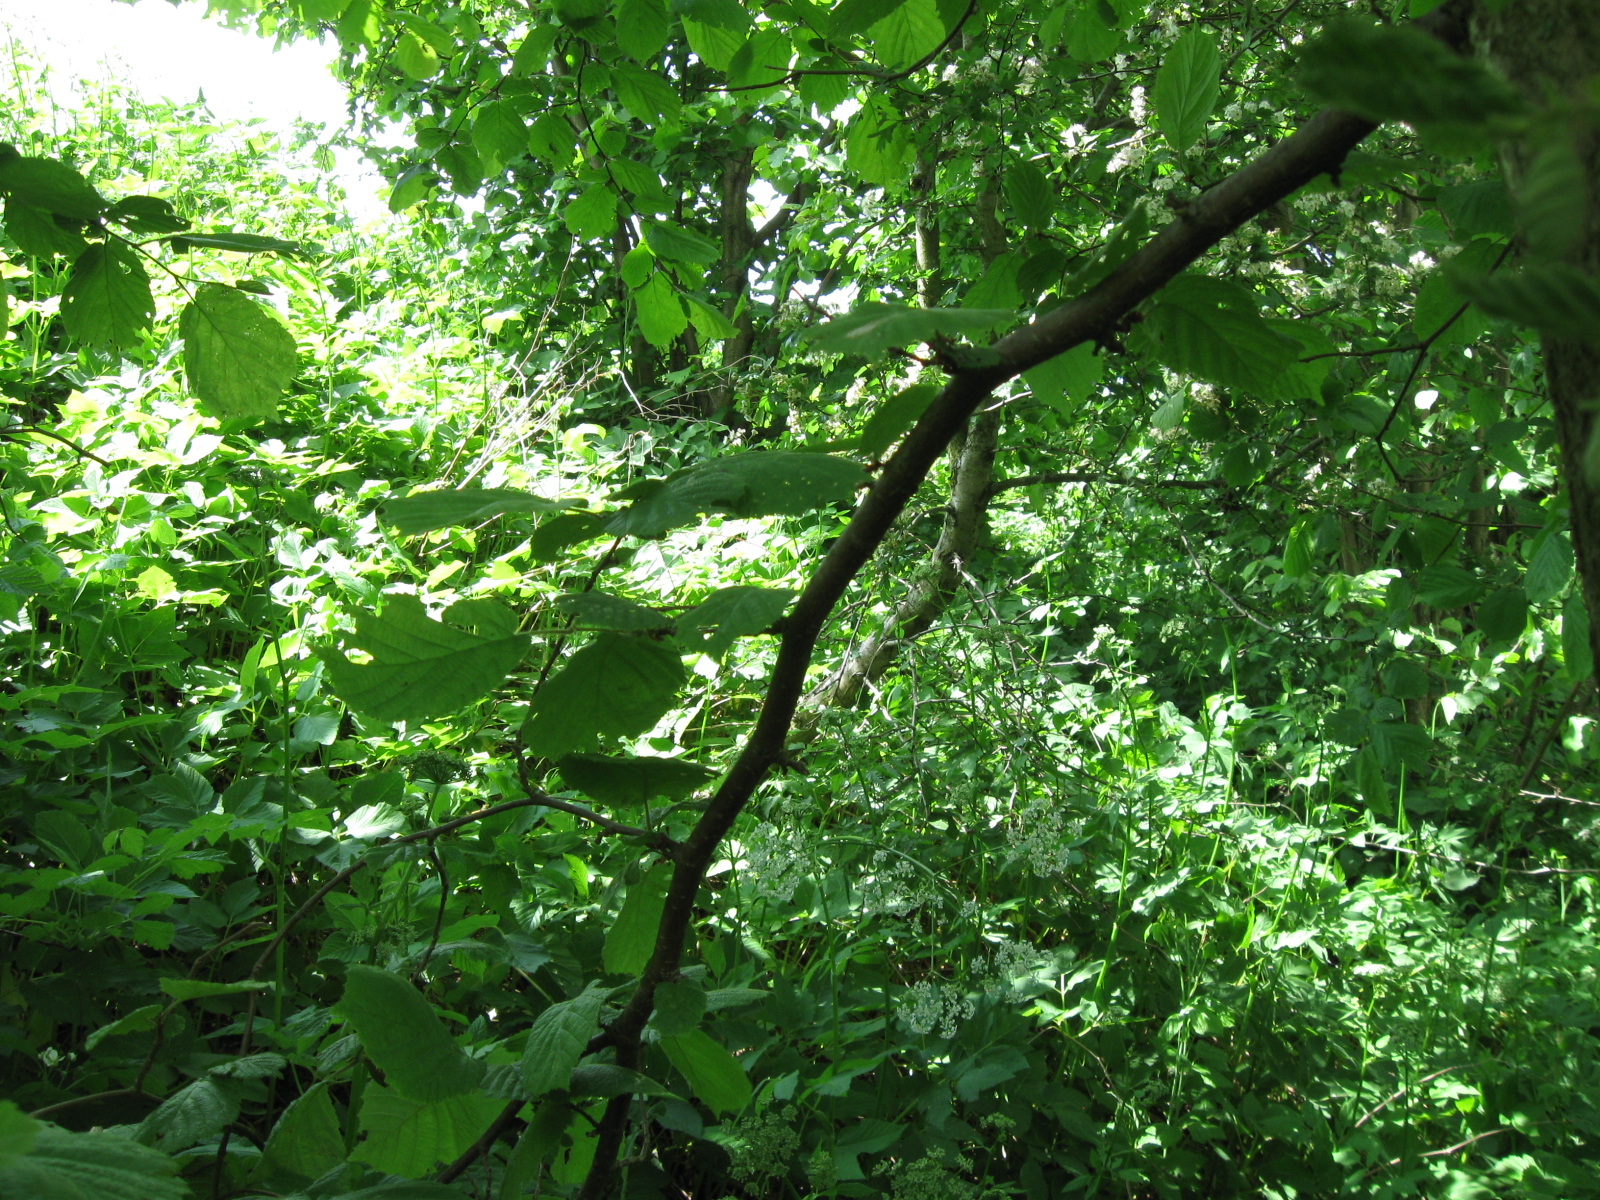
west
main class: Woodland
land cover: Broadleaved woodland
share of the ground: > 75 %
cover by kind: broadleaved forest trees 75 %, herbaceous plants 25 %
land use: Semi-natural and natural areas not in use
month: June
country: LT
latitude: 54.3488
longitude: 23.7330
